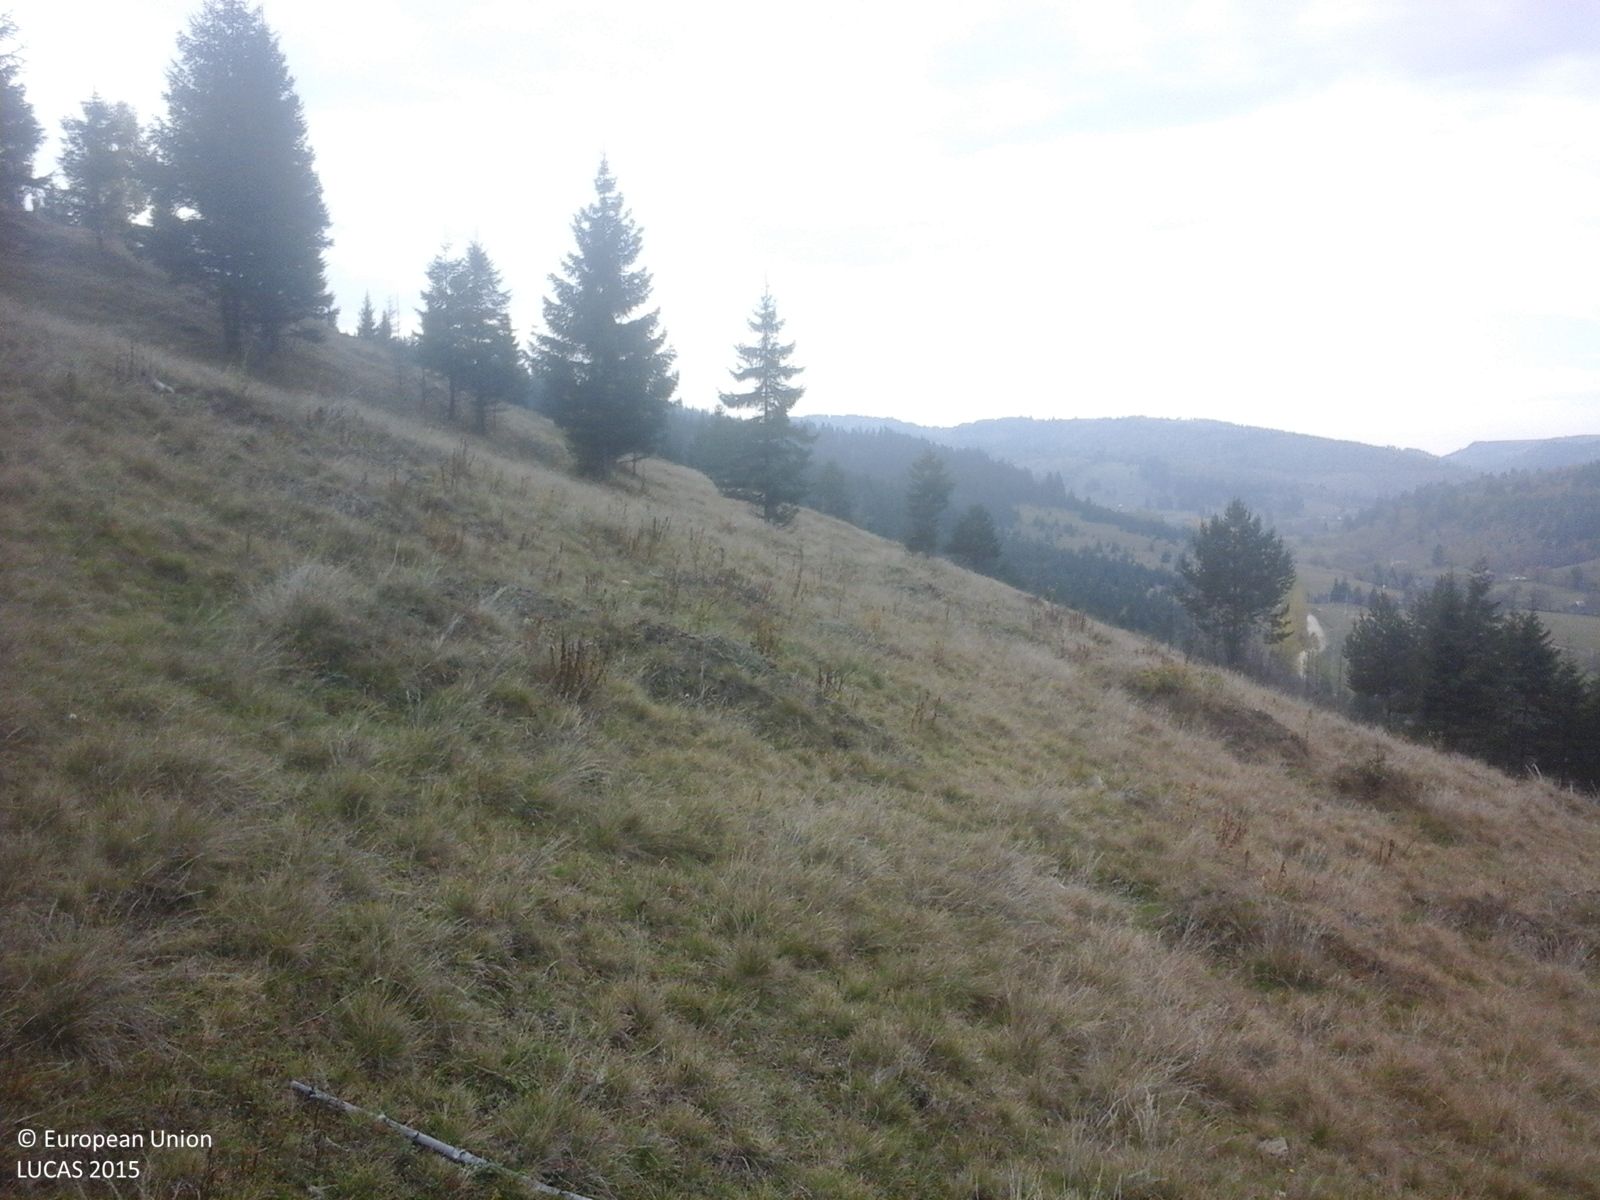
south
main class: Grassland
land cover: Grassland with sparse tree/shrub cover
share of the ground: > 75 %
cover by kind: herbaceous plants 85 %, shrubs 10 %, coniferous forest trees 5 %
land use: Forestry
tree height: > 5 m
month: October
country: RO
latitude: 46.3169
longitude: 26.0824
